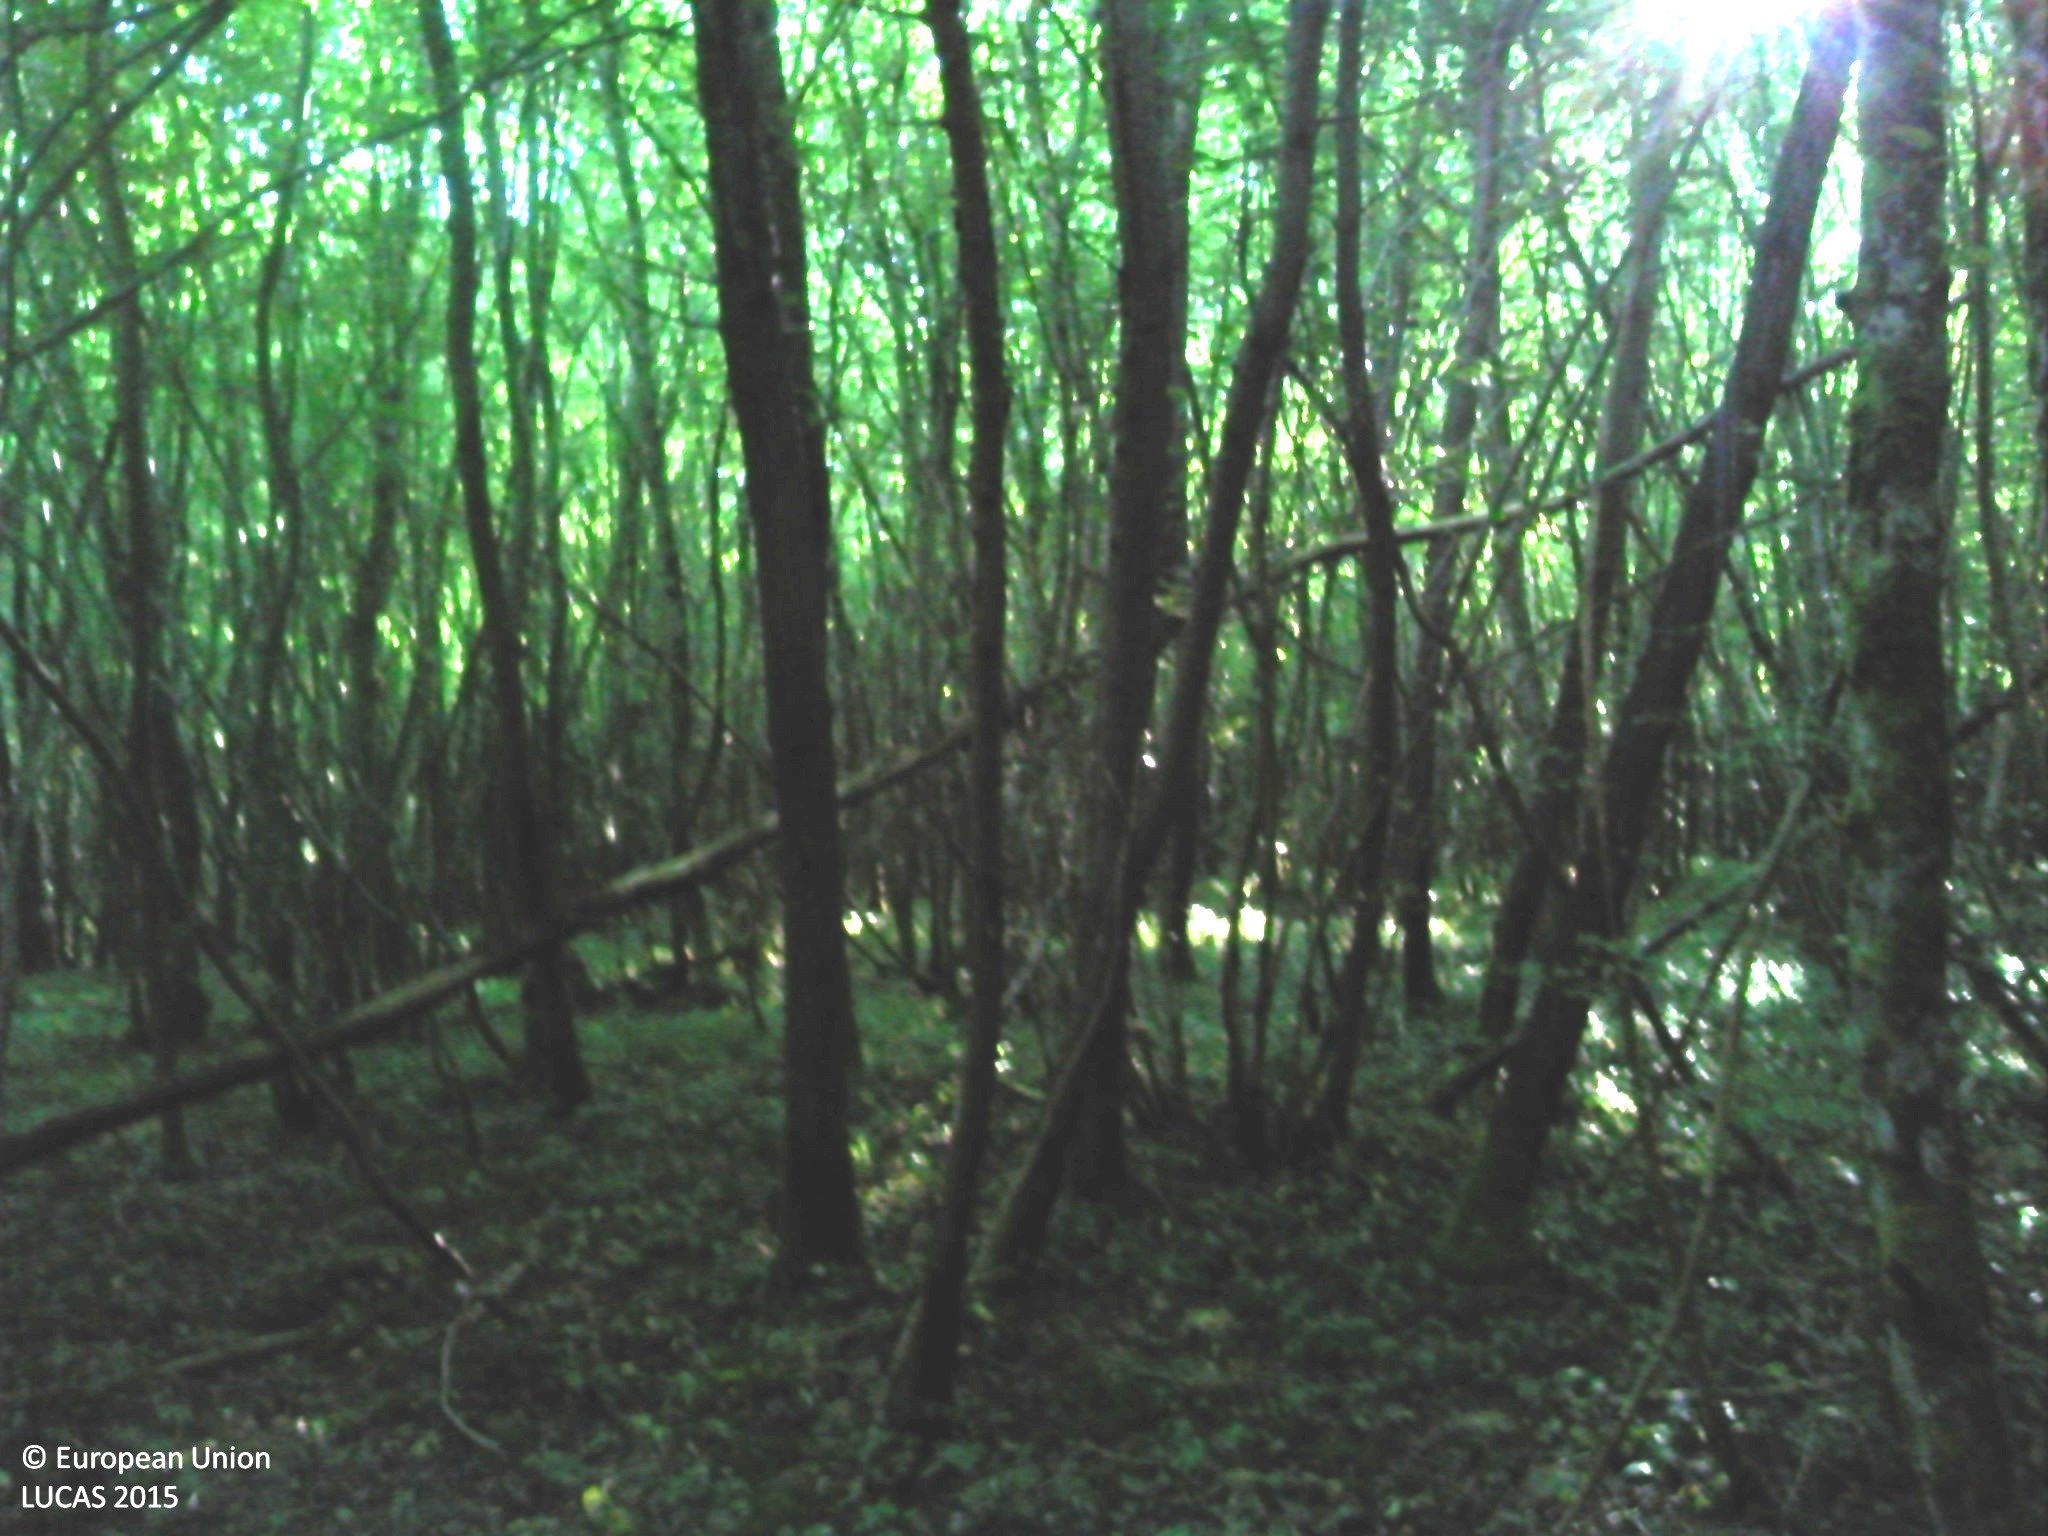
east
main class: Woodland
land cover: Broadleaved woodland
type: mesophytic deciduous forest
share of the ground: > 75 %
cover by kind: broadleaved forest trees 100 %
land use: Forestry
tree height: > 5 m
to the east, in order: Broadleaved woodland
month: July
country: FR
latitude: 47.0052
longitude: 3.2494
